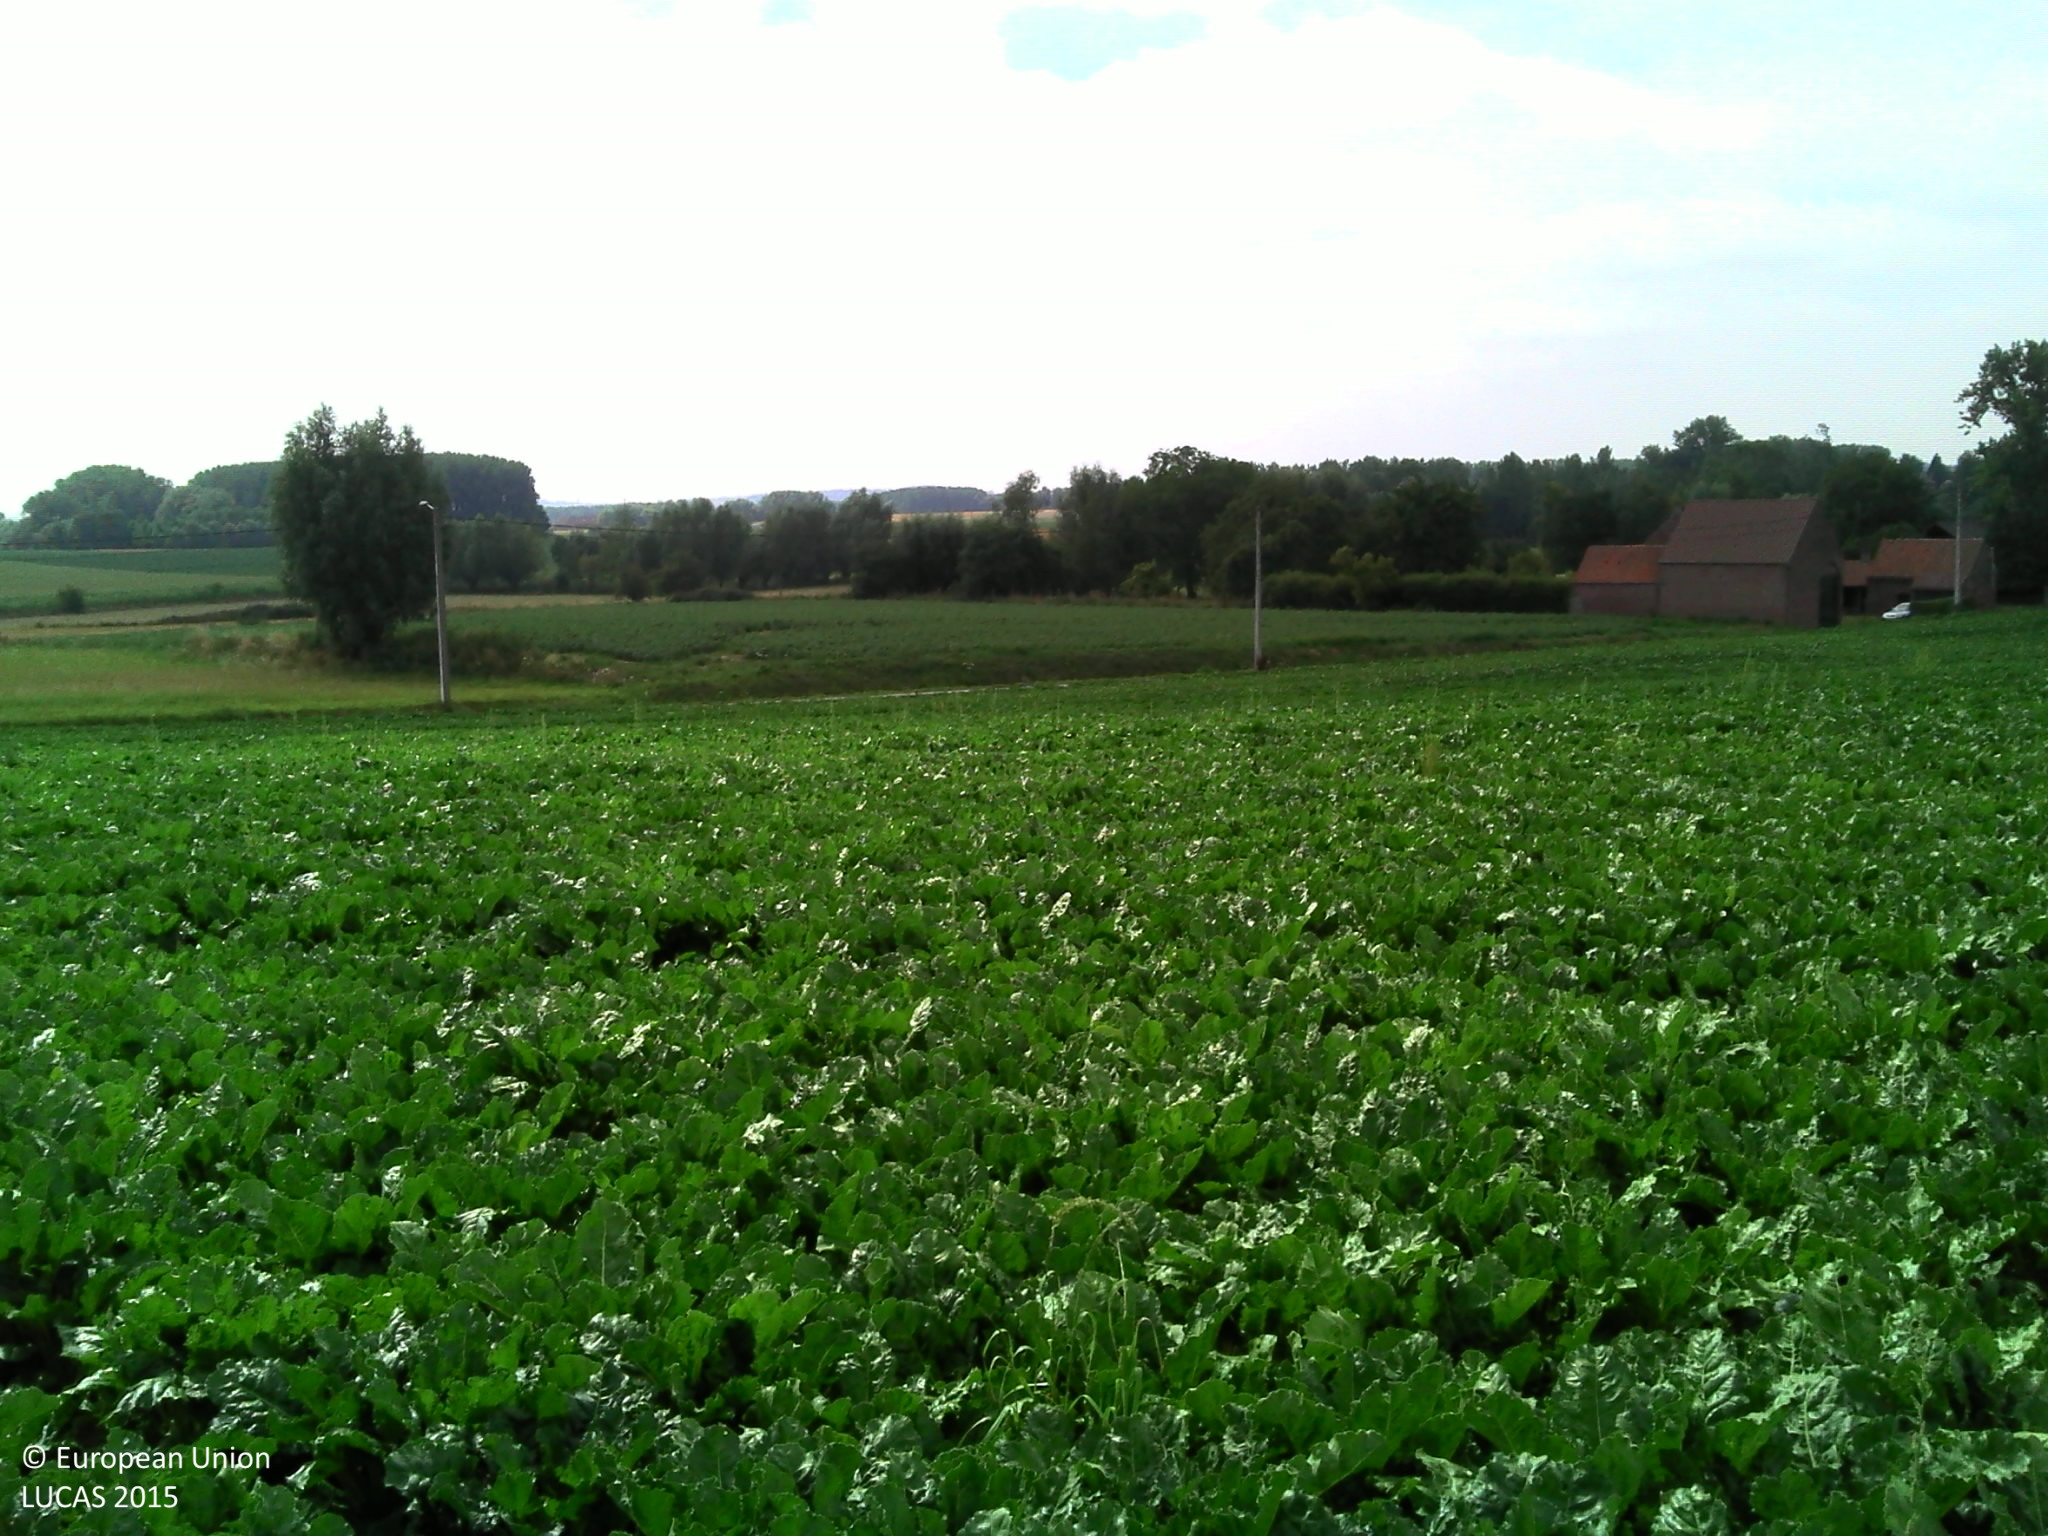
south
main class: Cropland
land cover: Sugar beet
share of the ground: > 75 %
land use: Agriculture (excluding fallow land and kitchen gardens)
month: August
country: BE
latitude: 50.7012
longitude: 3.8061
